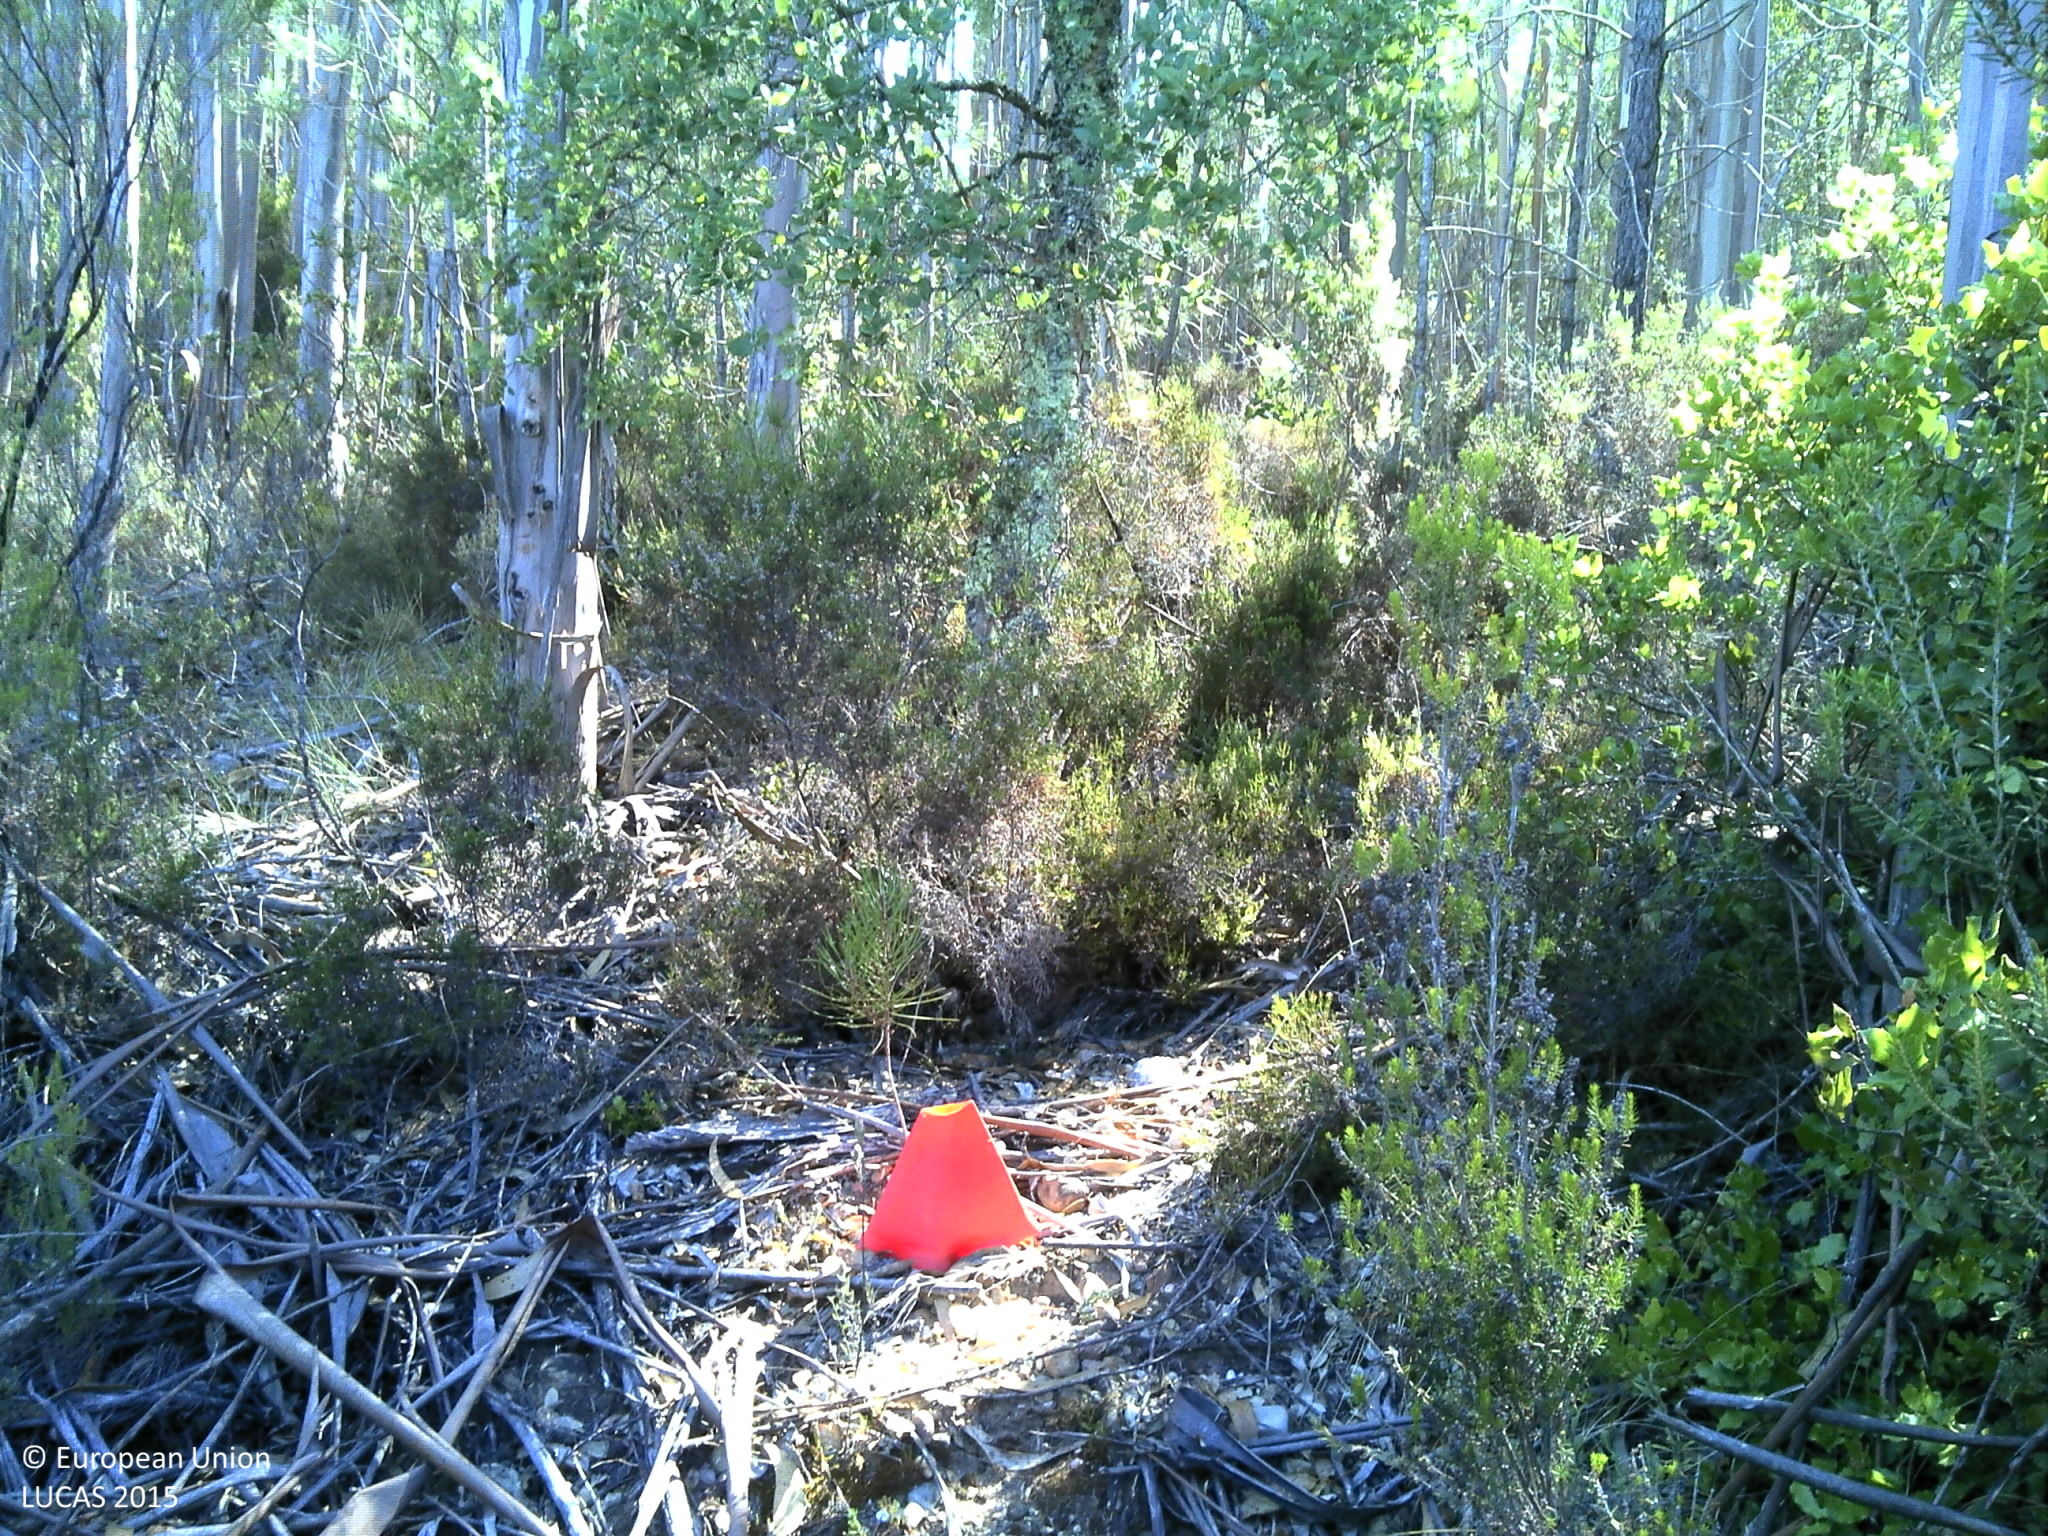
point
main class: Woodland
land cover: Broadleaved woodland
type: exotic forest
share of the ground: 50 - 75 %
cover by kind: broadleaved forest trees 60 %, shrubs 20 %, consolidated bare surface 10 %, unconsolidated bare surface 10 %
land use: Forestry
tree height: > 5 m
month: July
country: PT
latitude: 39.7827
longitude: -8.4192
